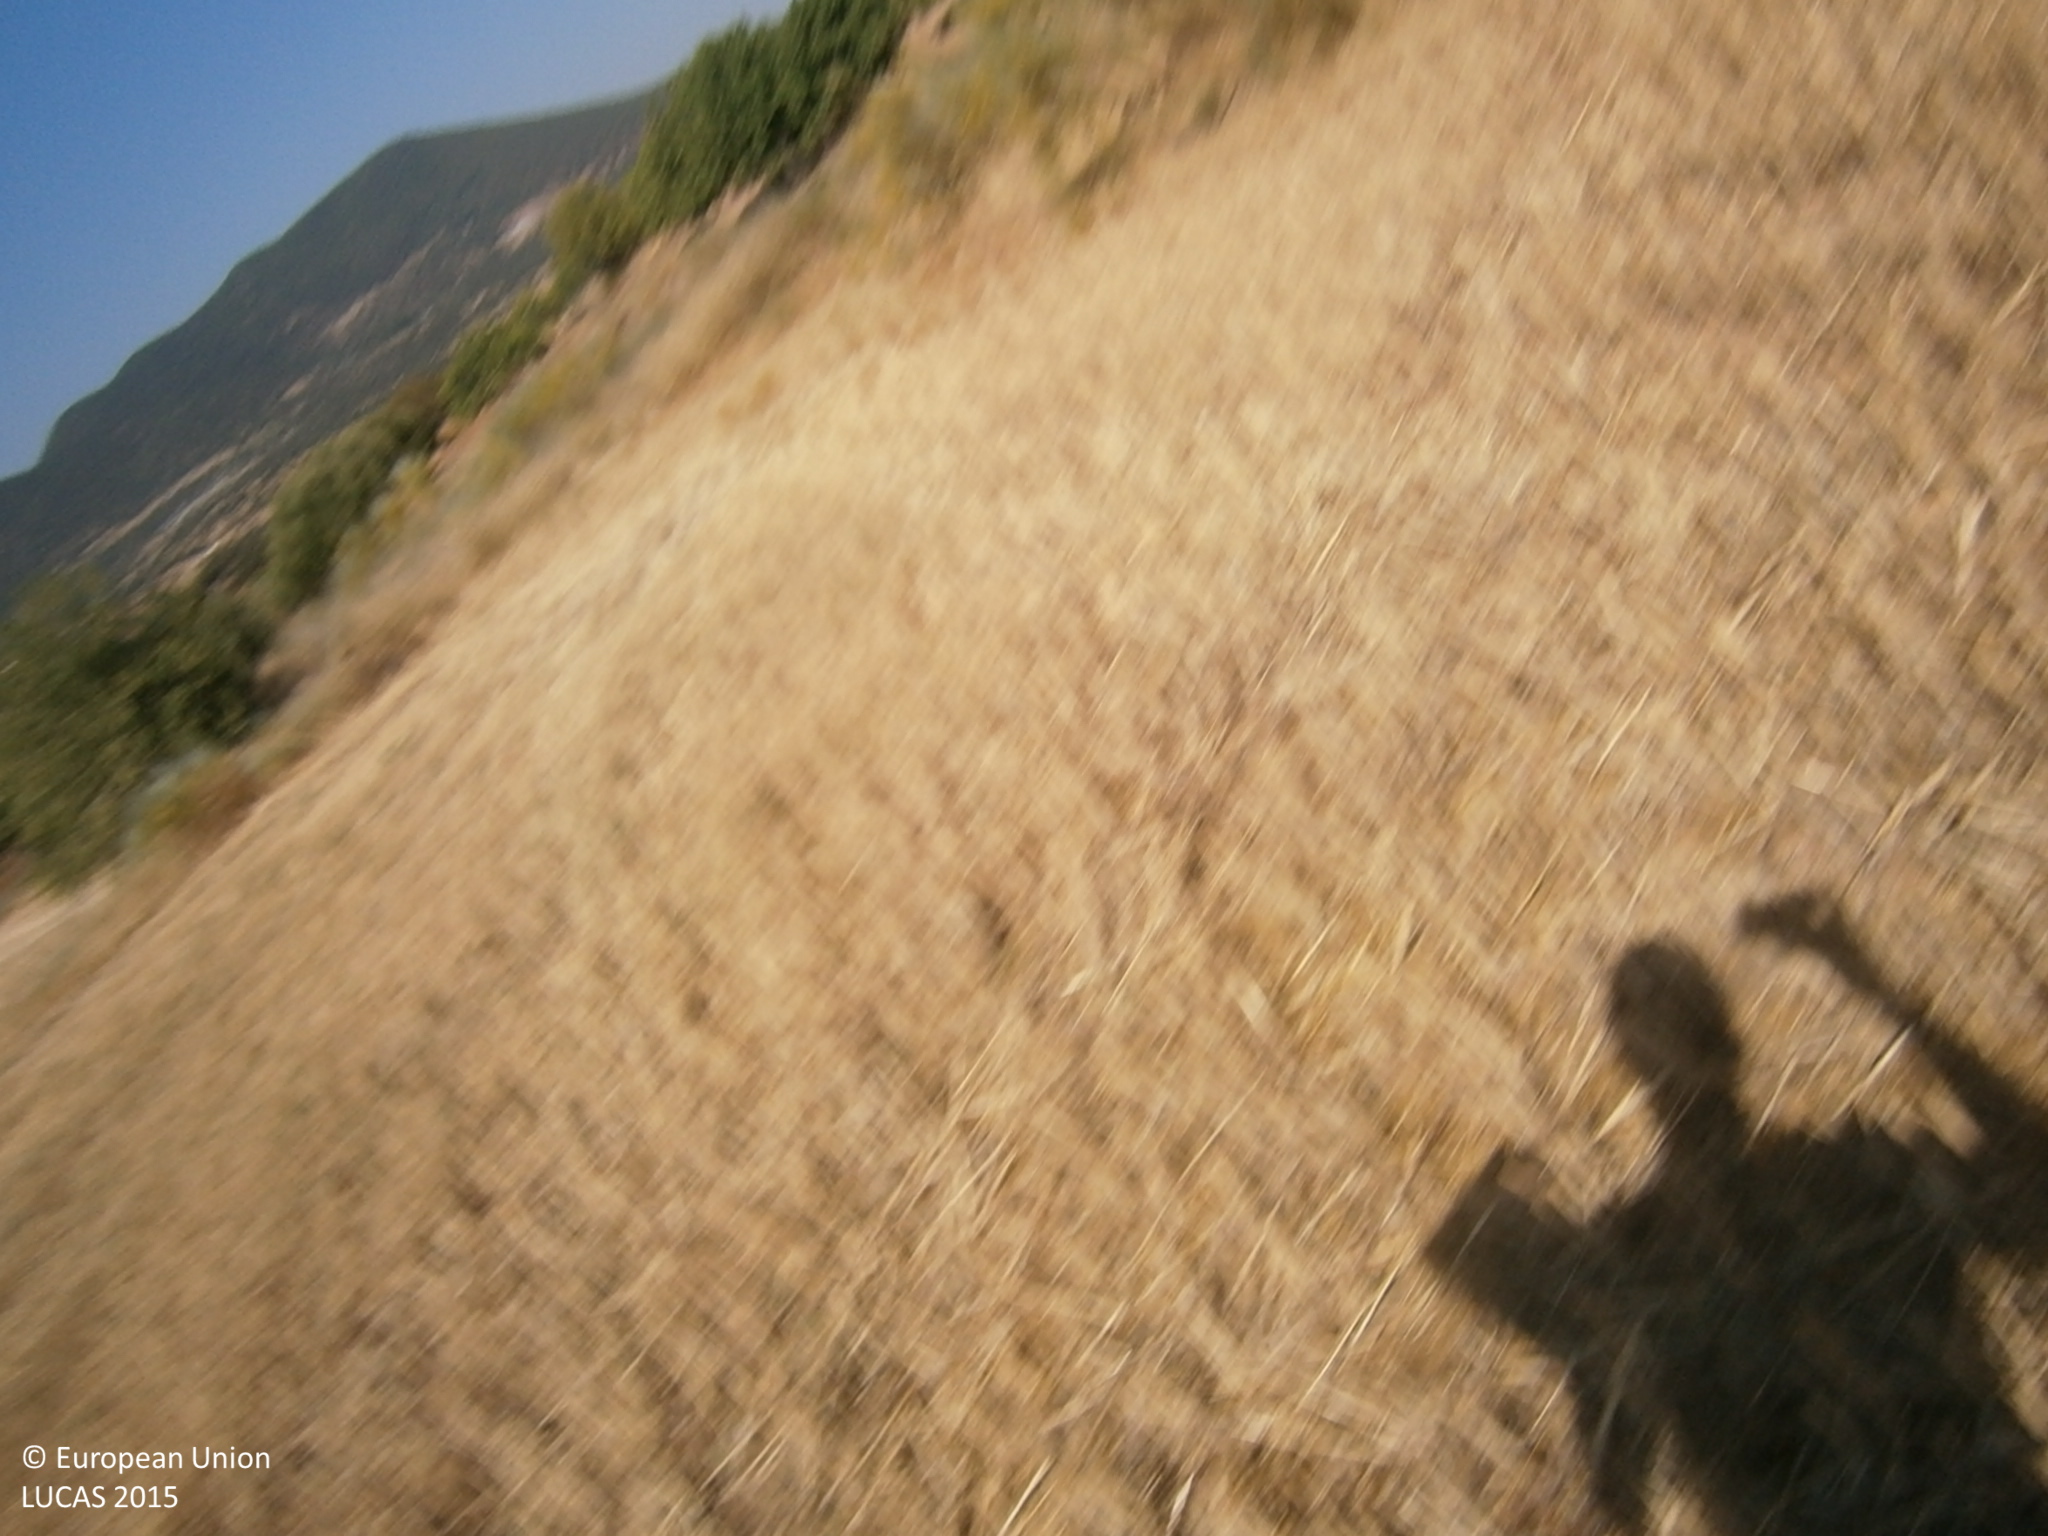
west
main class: Cropland
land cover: Dry pulses
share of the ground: > 75 %
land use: Agriculture (excluding fallow land and kitchen gardens)
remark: Harvested field
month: June
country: ES
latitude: 38.5781
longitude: -6.7382
